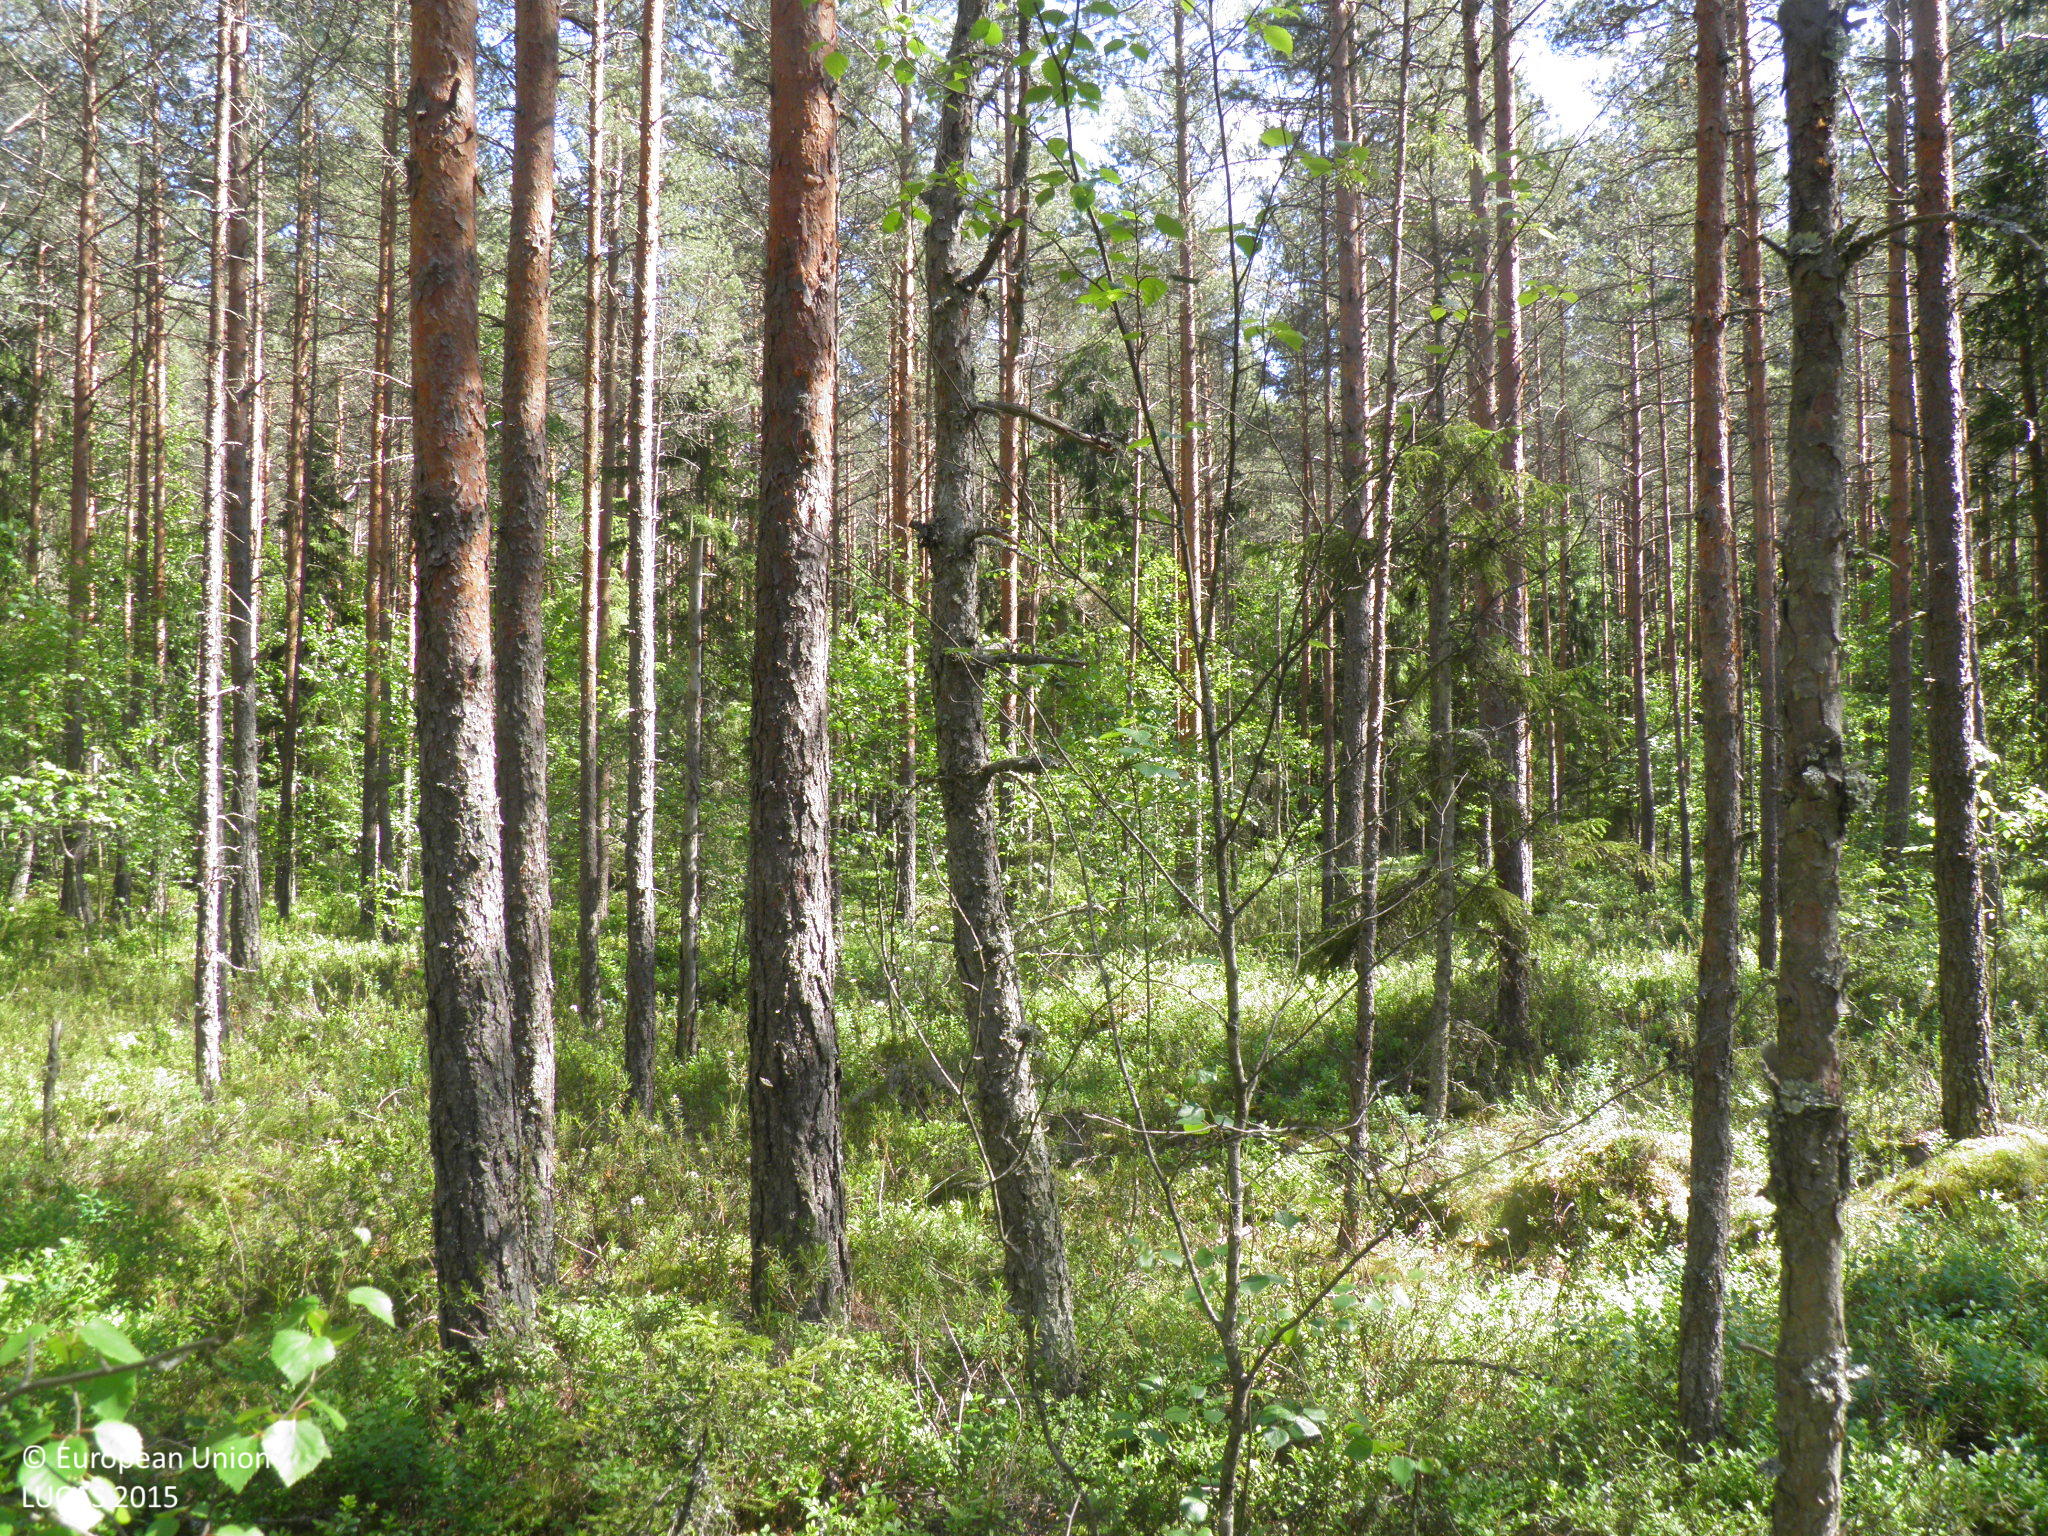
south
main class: Woodland
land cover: Pine dominated coniferous woodland
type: hemiboreal forest and nemoral coniferous forest and mixed broadleaved-coniferous forest
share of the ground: > 75 %
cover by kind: coniferous forest trees 75 %, shrubs 15 %, lichens and mosses 10 %
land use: Forestry
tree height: > 5 m
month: June
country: FI
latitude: 60.4726
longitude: 22.7898
